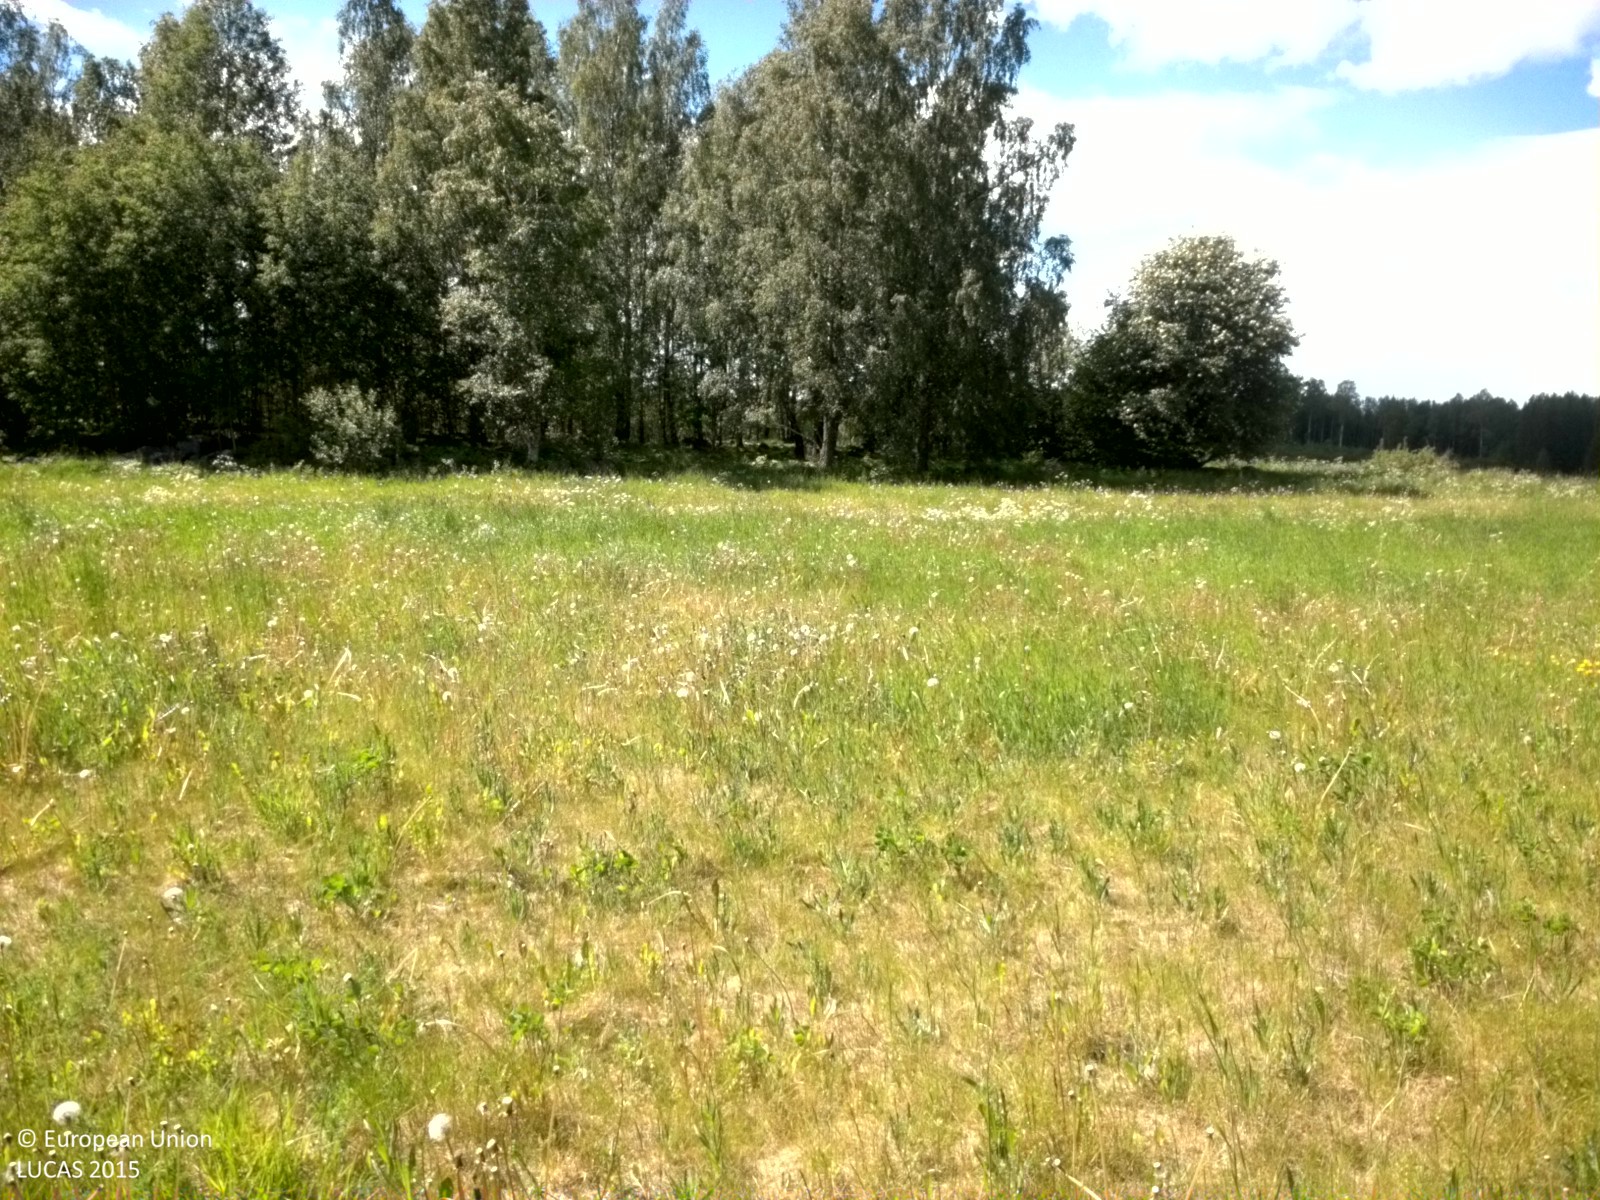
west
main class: Grassland
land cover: Grassland without tree/shrub cover
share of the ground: > 75 %
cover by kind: herbaceous plants 100 %
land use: Agriculture (excluding fallow land and kitchen gardens)
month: June
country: SE
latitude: 60.2335
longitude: 17.8484
